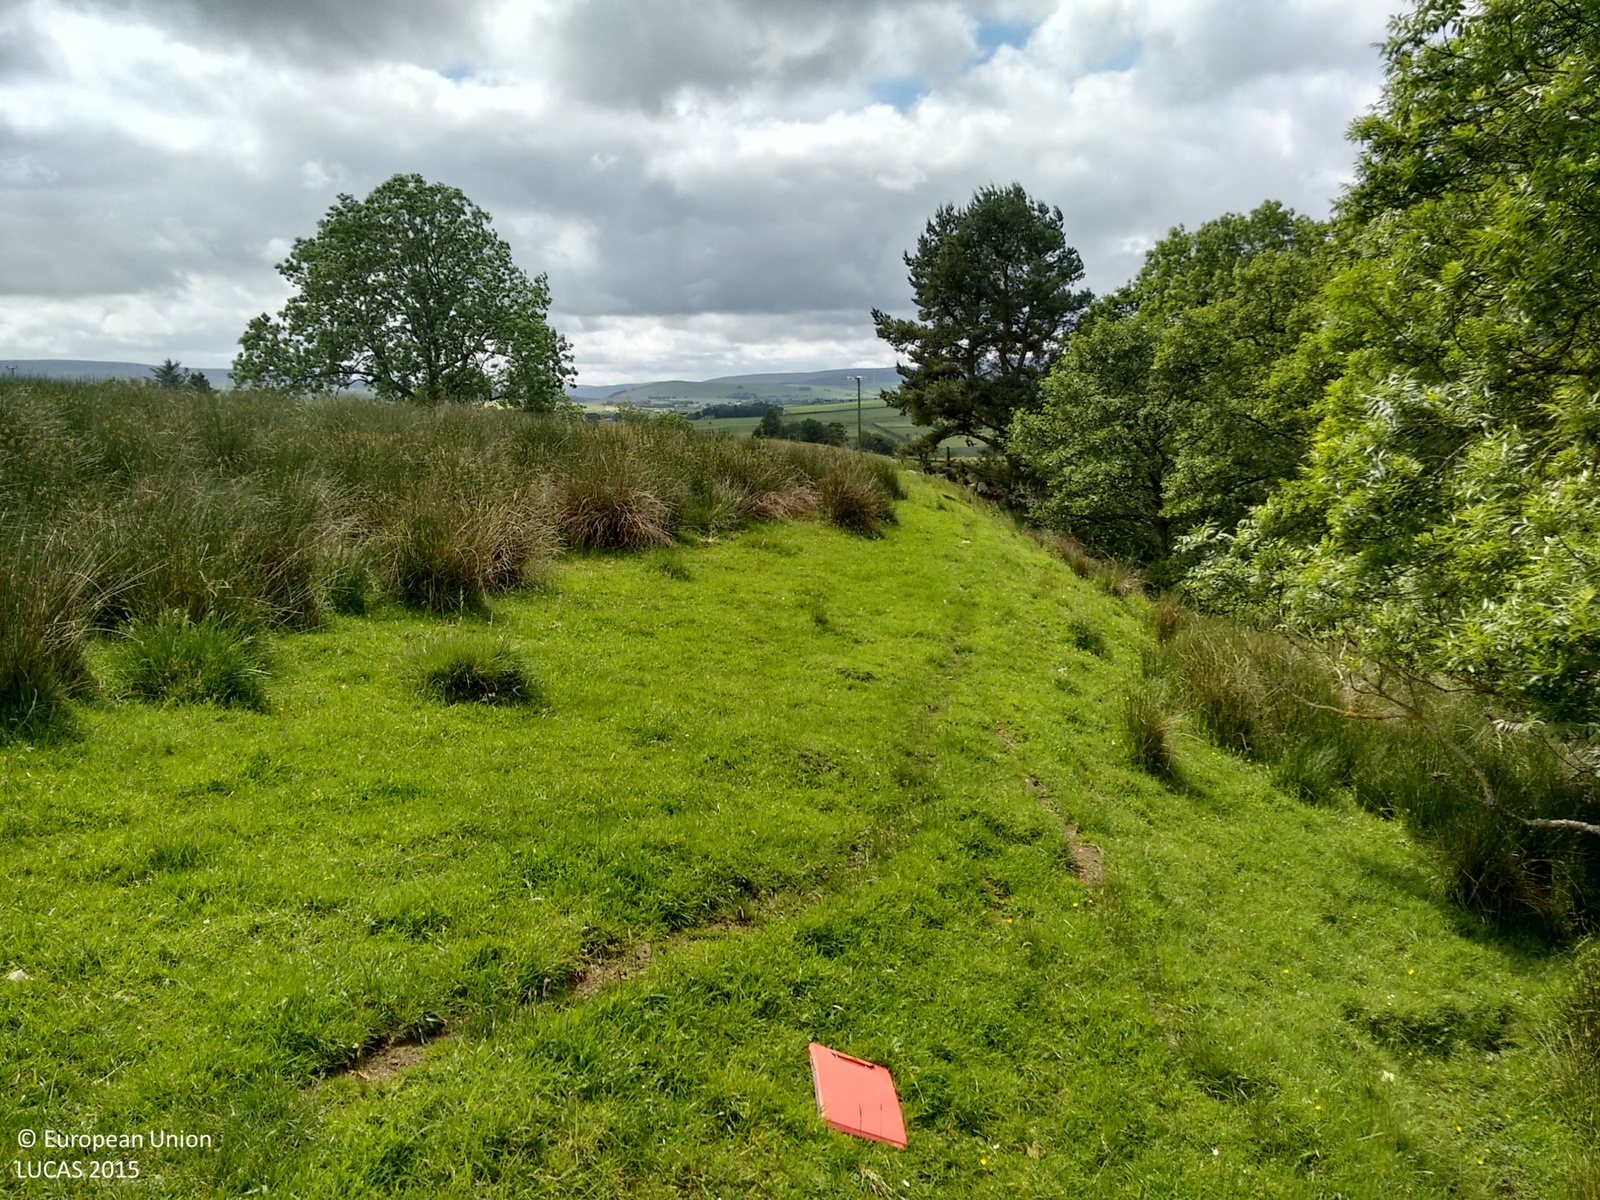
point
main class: Grassland
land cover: Grassland without tree/shrub cover
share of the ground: > 75 %
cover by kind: herbaceous plants 100 %
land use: Agriculture (excluding fallow land and kitchen gardens)
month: July
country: GB
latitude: 57.3691
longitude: -2.7782
